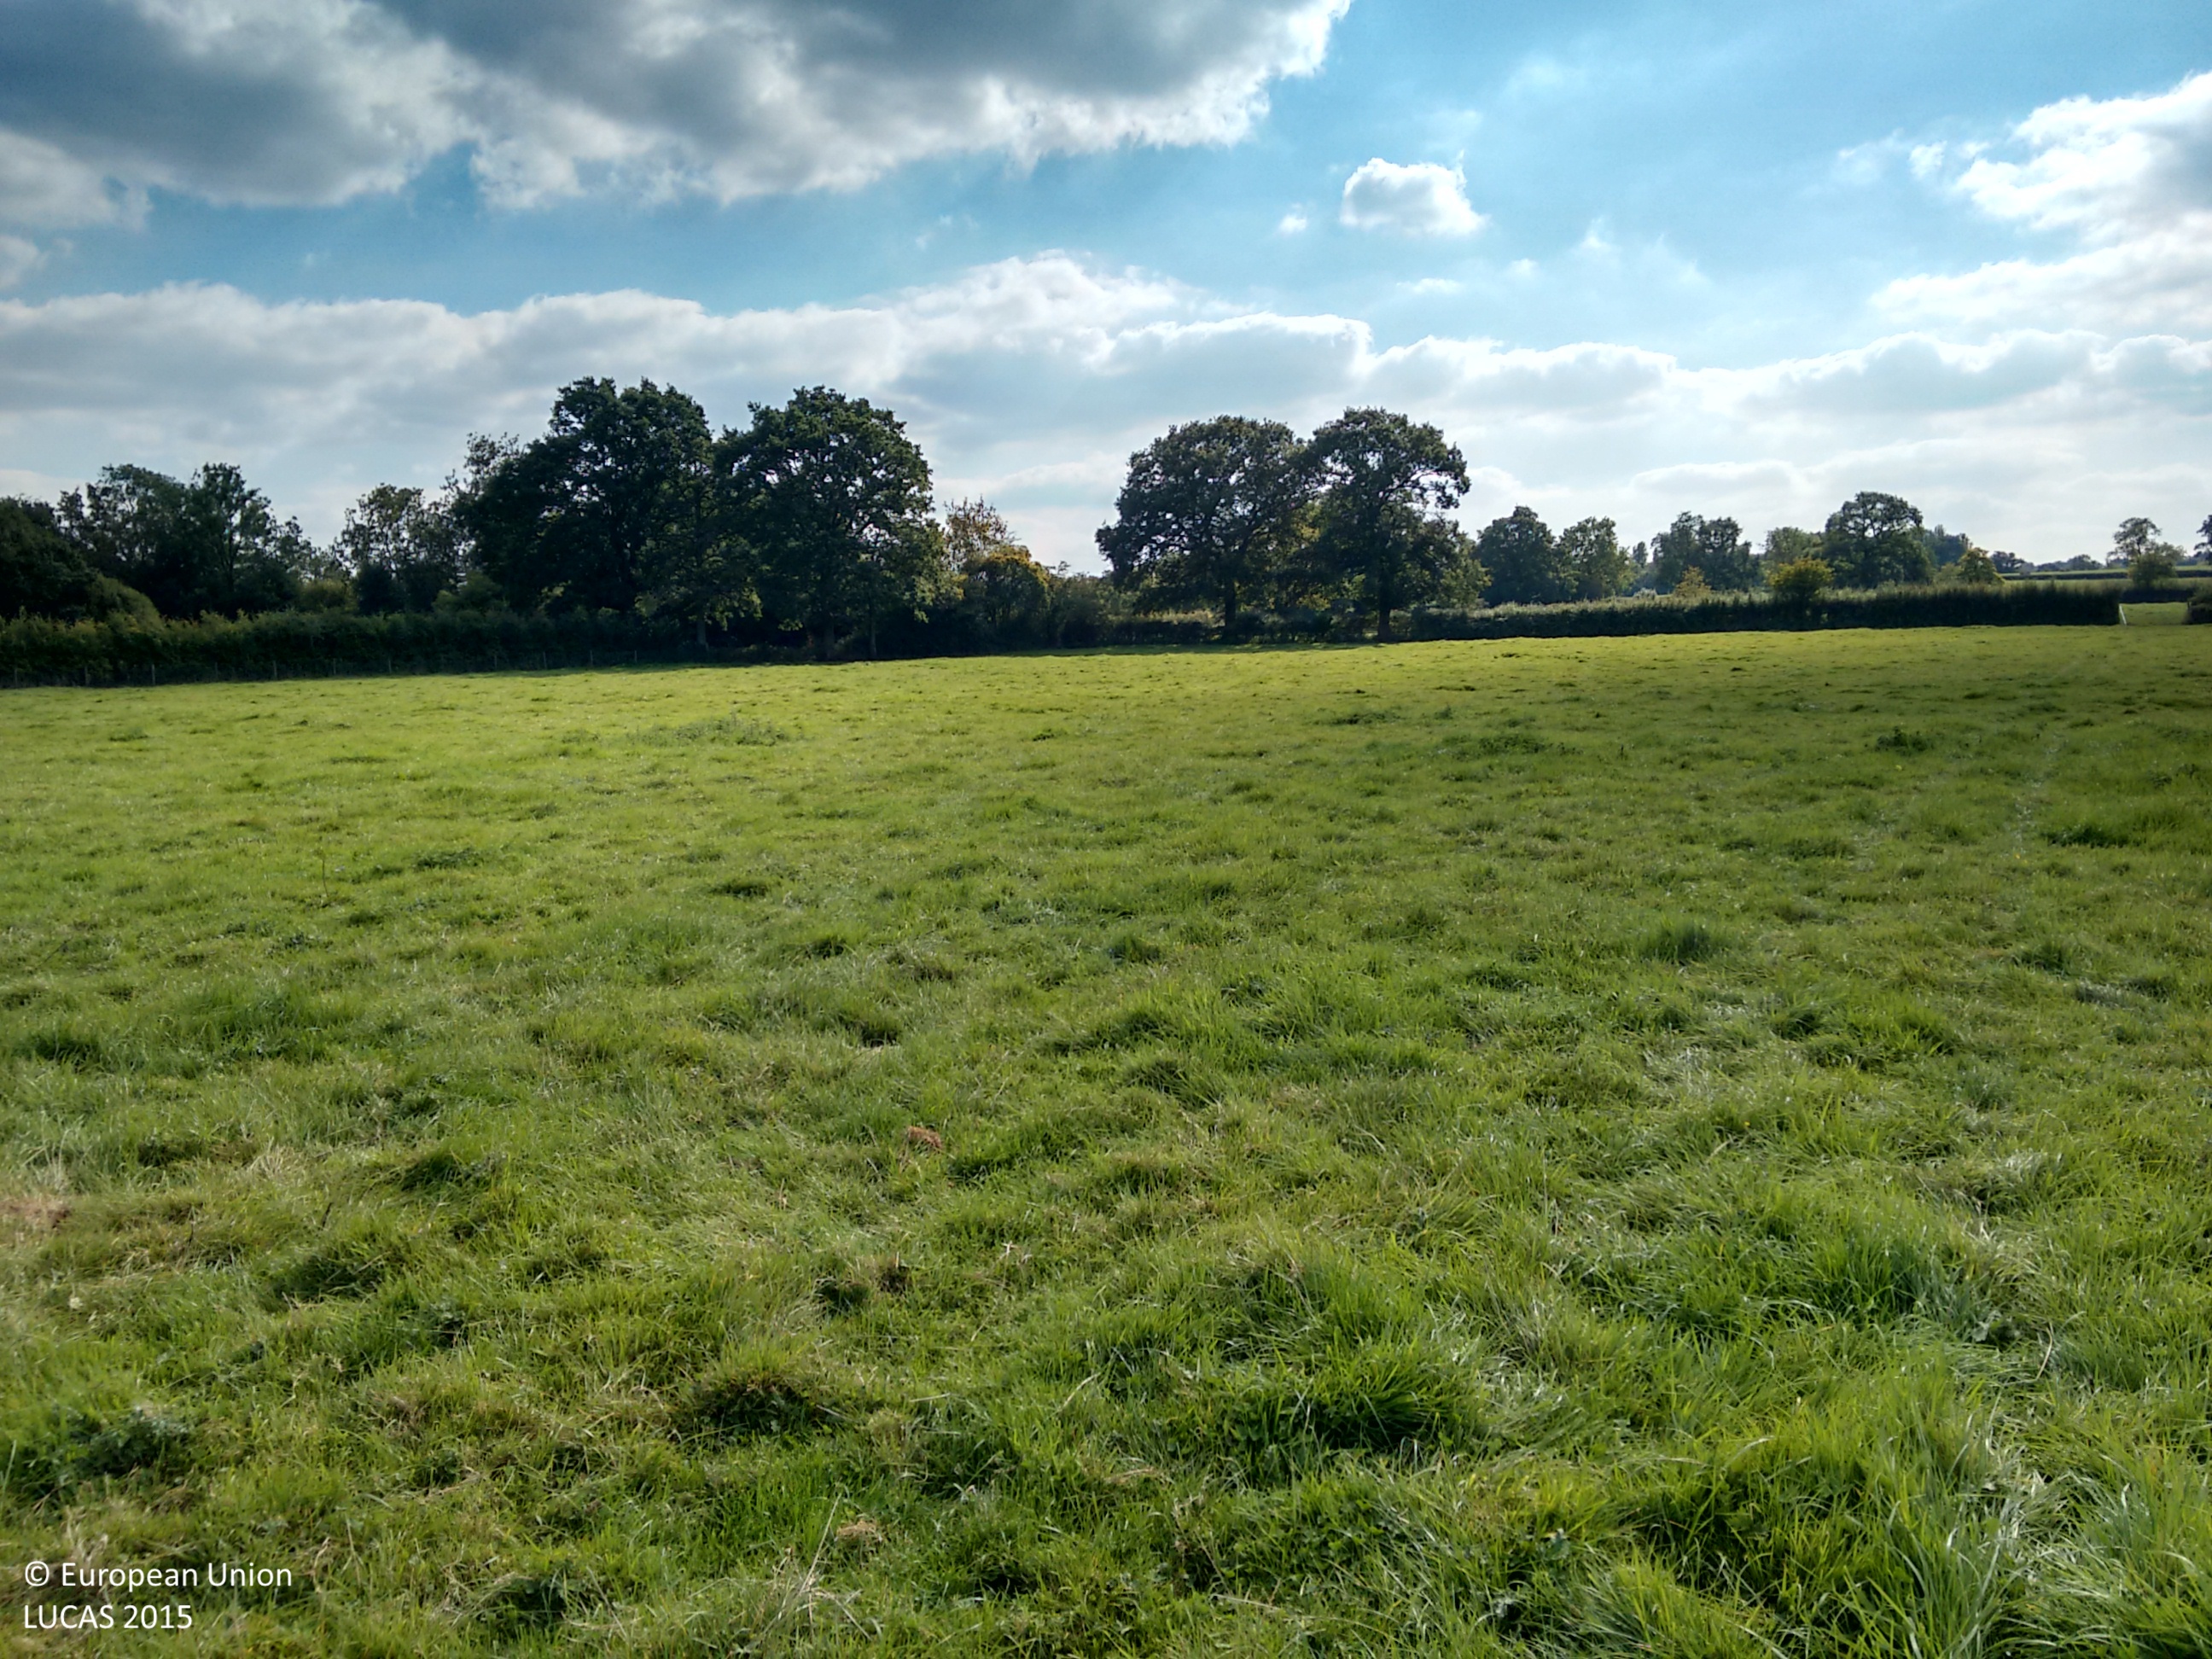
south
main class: Grassland
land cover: Grassland without tree/shrub cover
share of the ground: > 75 %
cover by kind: herbaceous plants 100 %
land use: Agriculture (excluding fallow land and kitchen gardens)
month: September
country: GB
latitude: 51.8879
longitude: -2.4004
